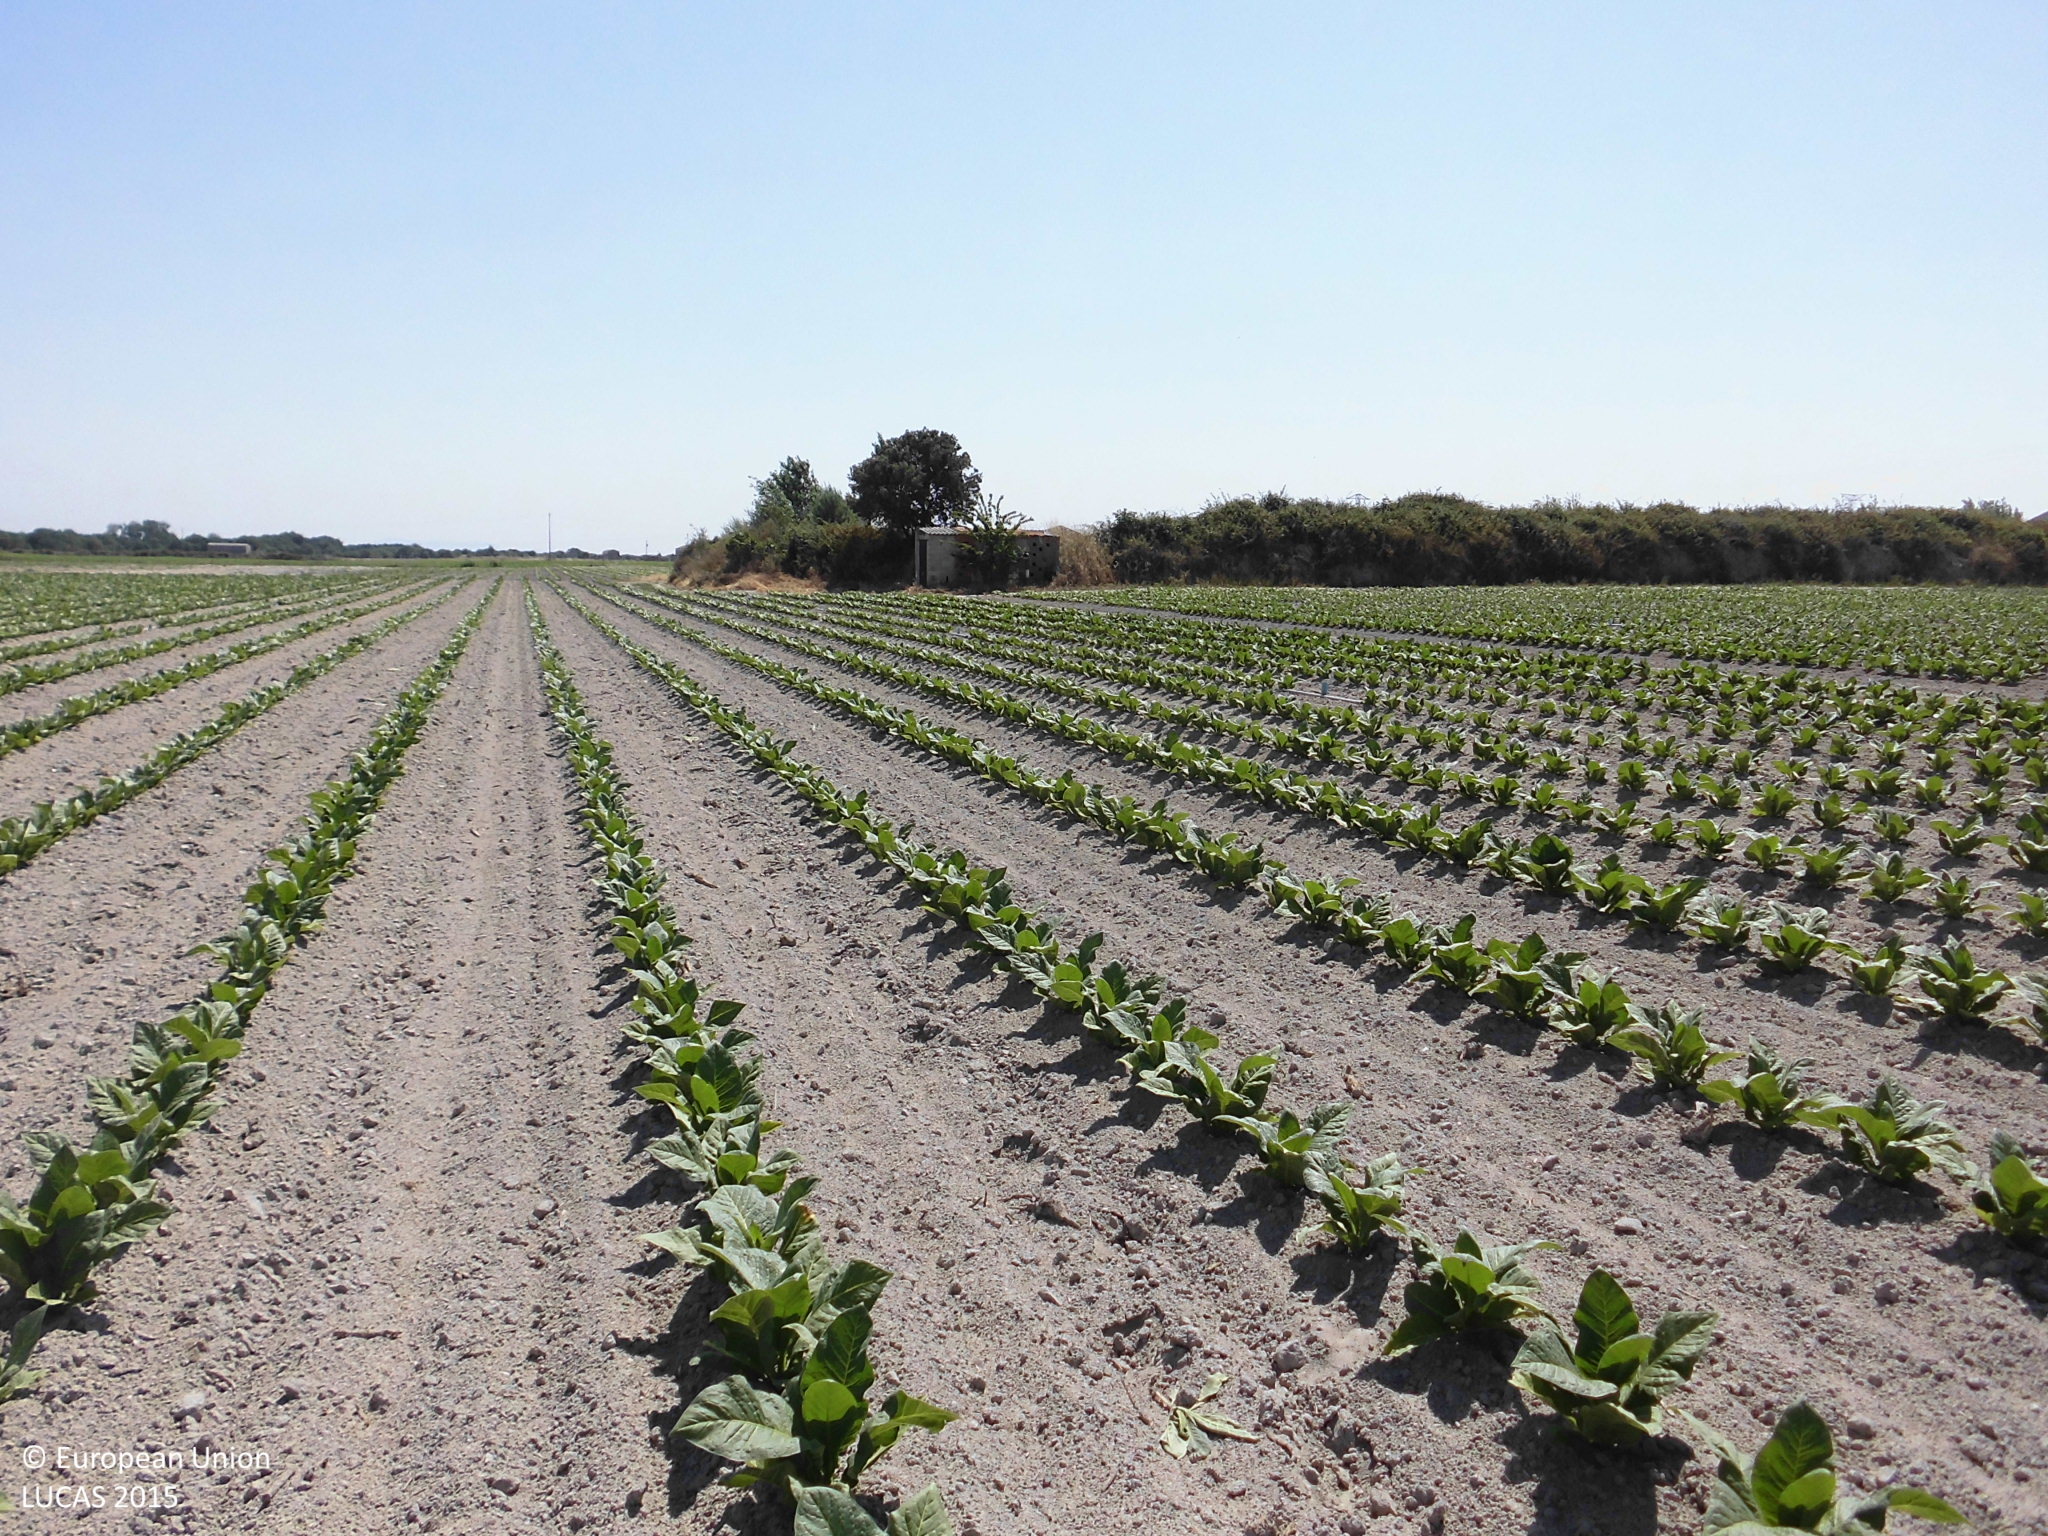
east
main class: Cropland
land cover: Tobacco
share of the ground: 10 - 25 %
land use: Agriculture (excluding fallow land and kitchen gardens)
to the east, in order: Tobacco; Single bushes/trees; Grass margins; Tracks; Tobacco
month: June
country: ES
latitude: 39.9931
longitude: -5.4365
